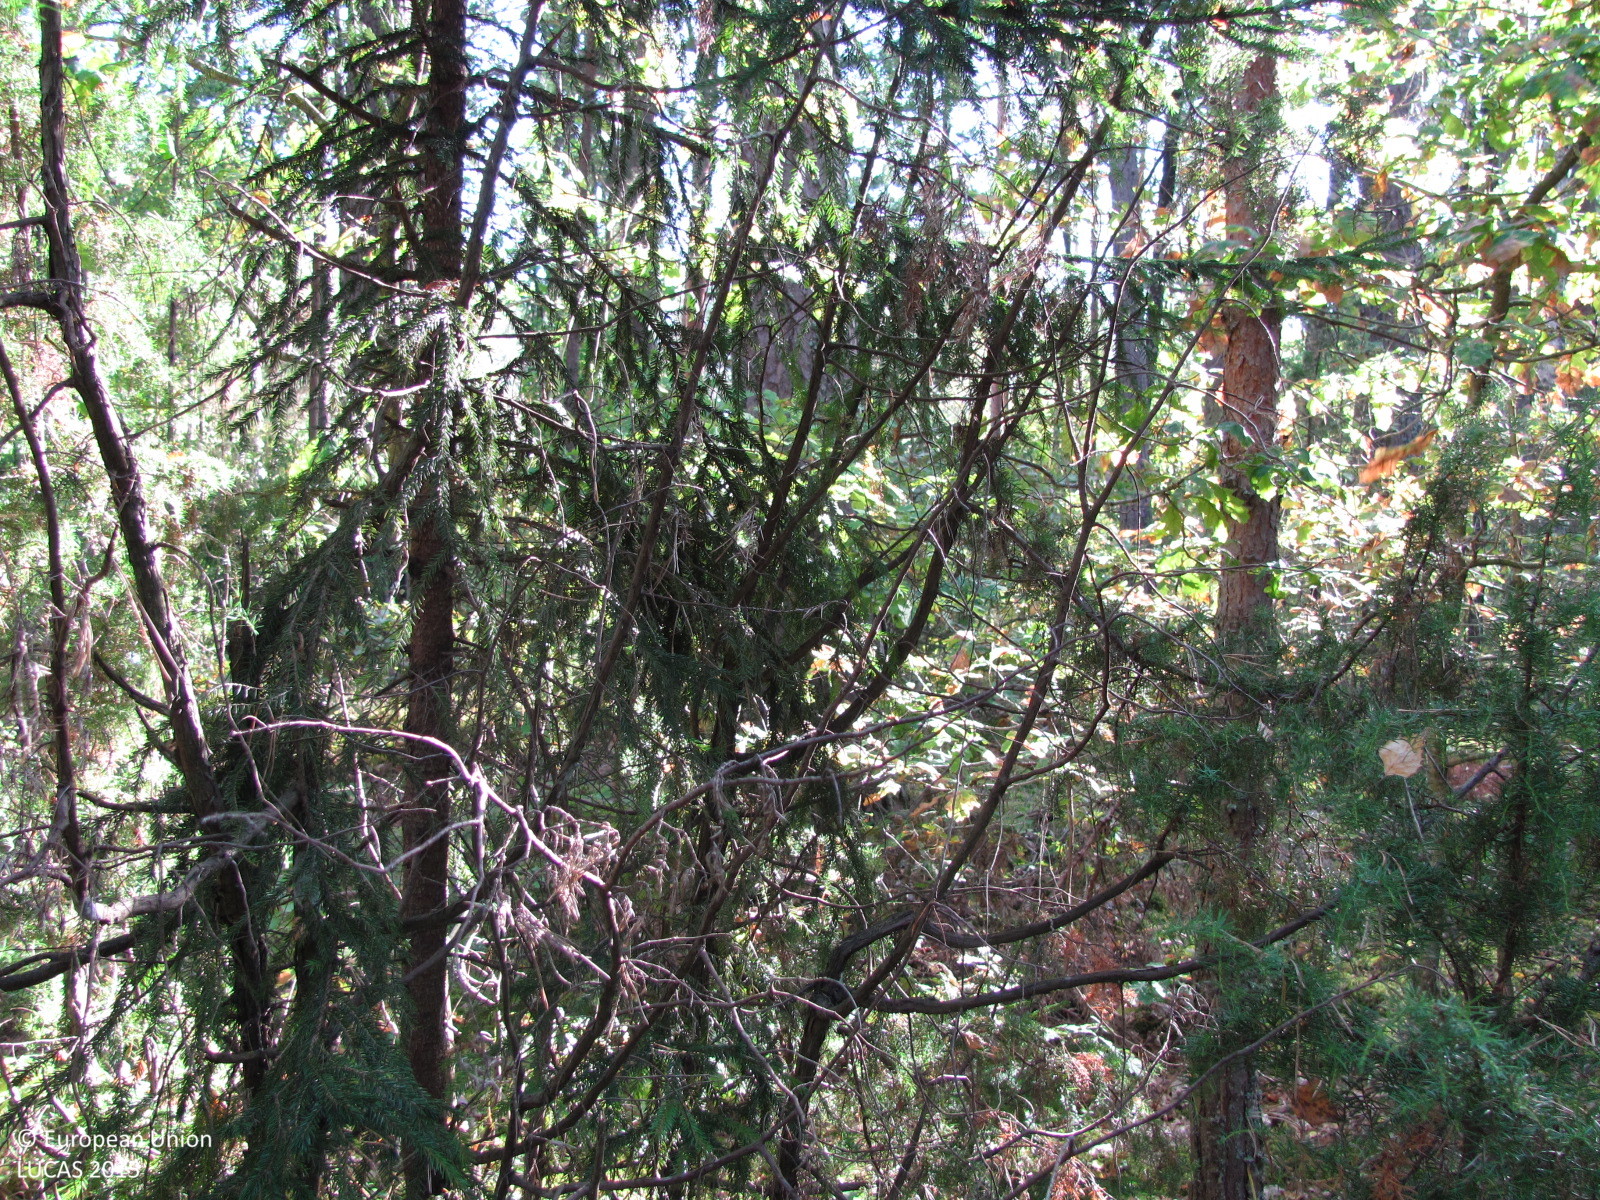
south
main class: Woodland
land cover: Pine dominated mixed woodland
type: hemiboreal forest and nemoral coniferous forest and mixed broadleaved-coniferous forest
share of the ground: > 75 %
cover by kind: coniferous forest trees 60 %, broadleaved forest trees 25 %, herbaceous plants 10 %, lichens and mosses 5 %
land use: Forestry
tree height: > 5 m
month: September
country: LV
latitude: 57.0692
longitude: 24.4243
